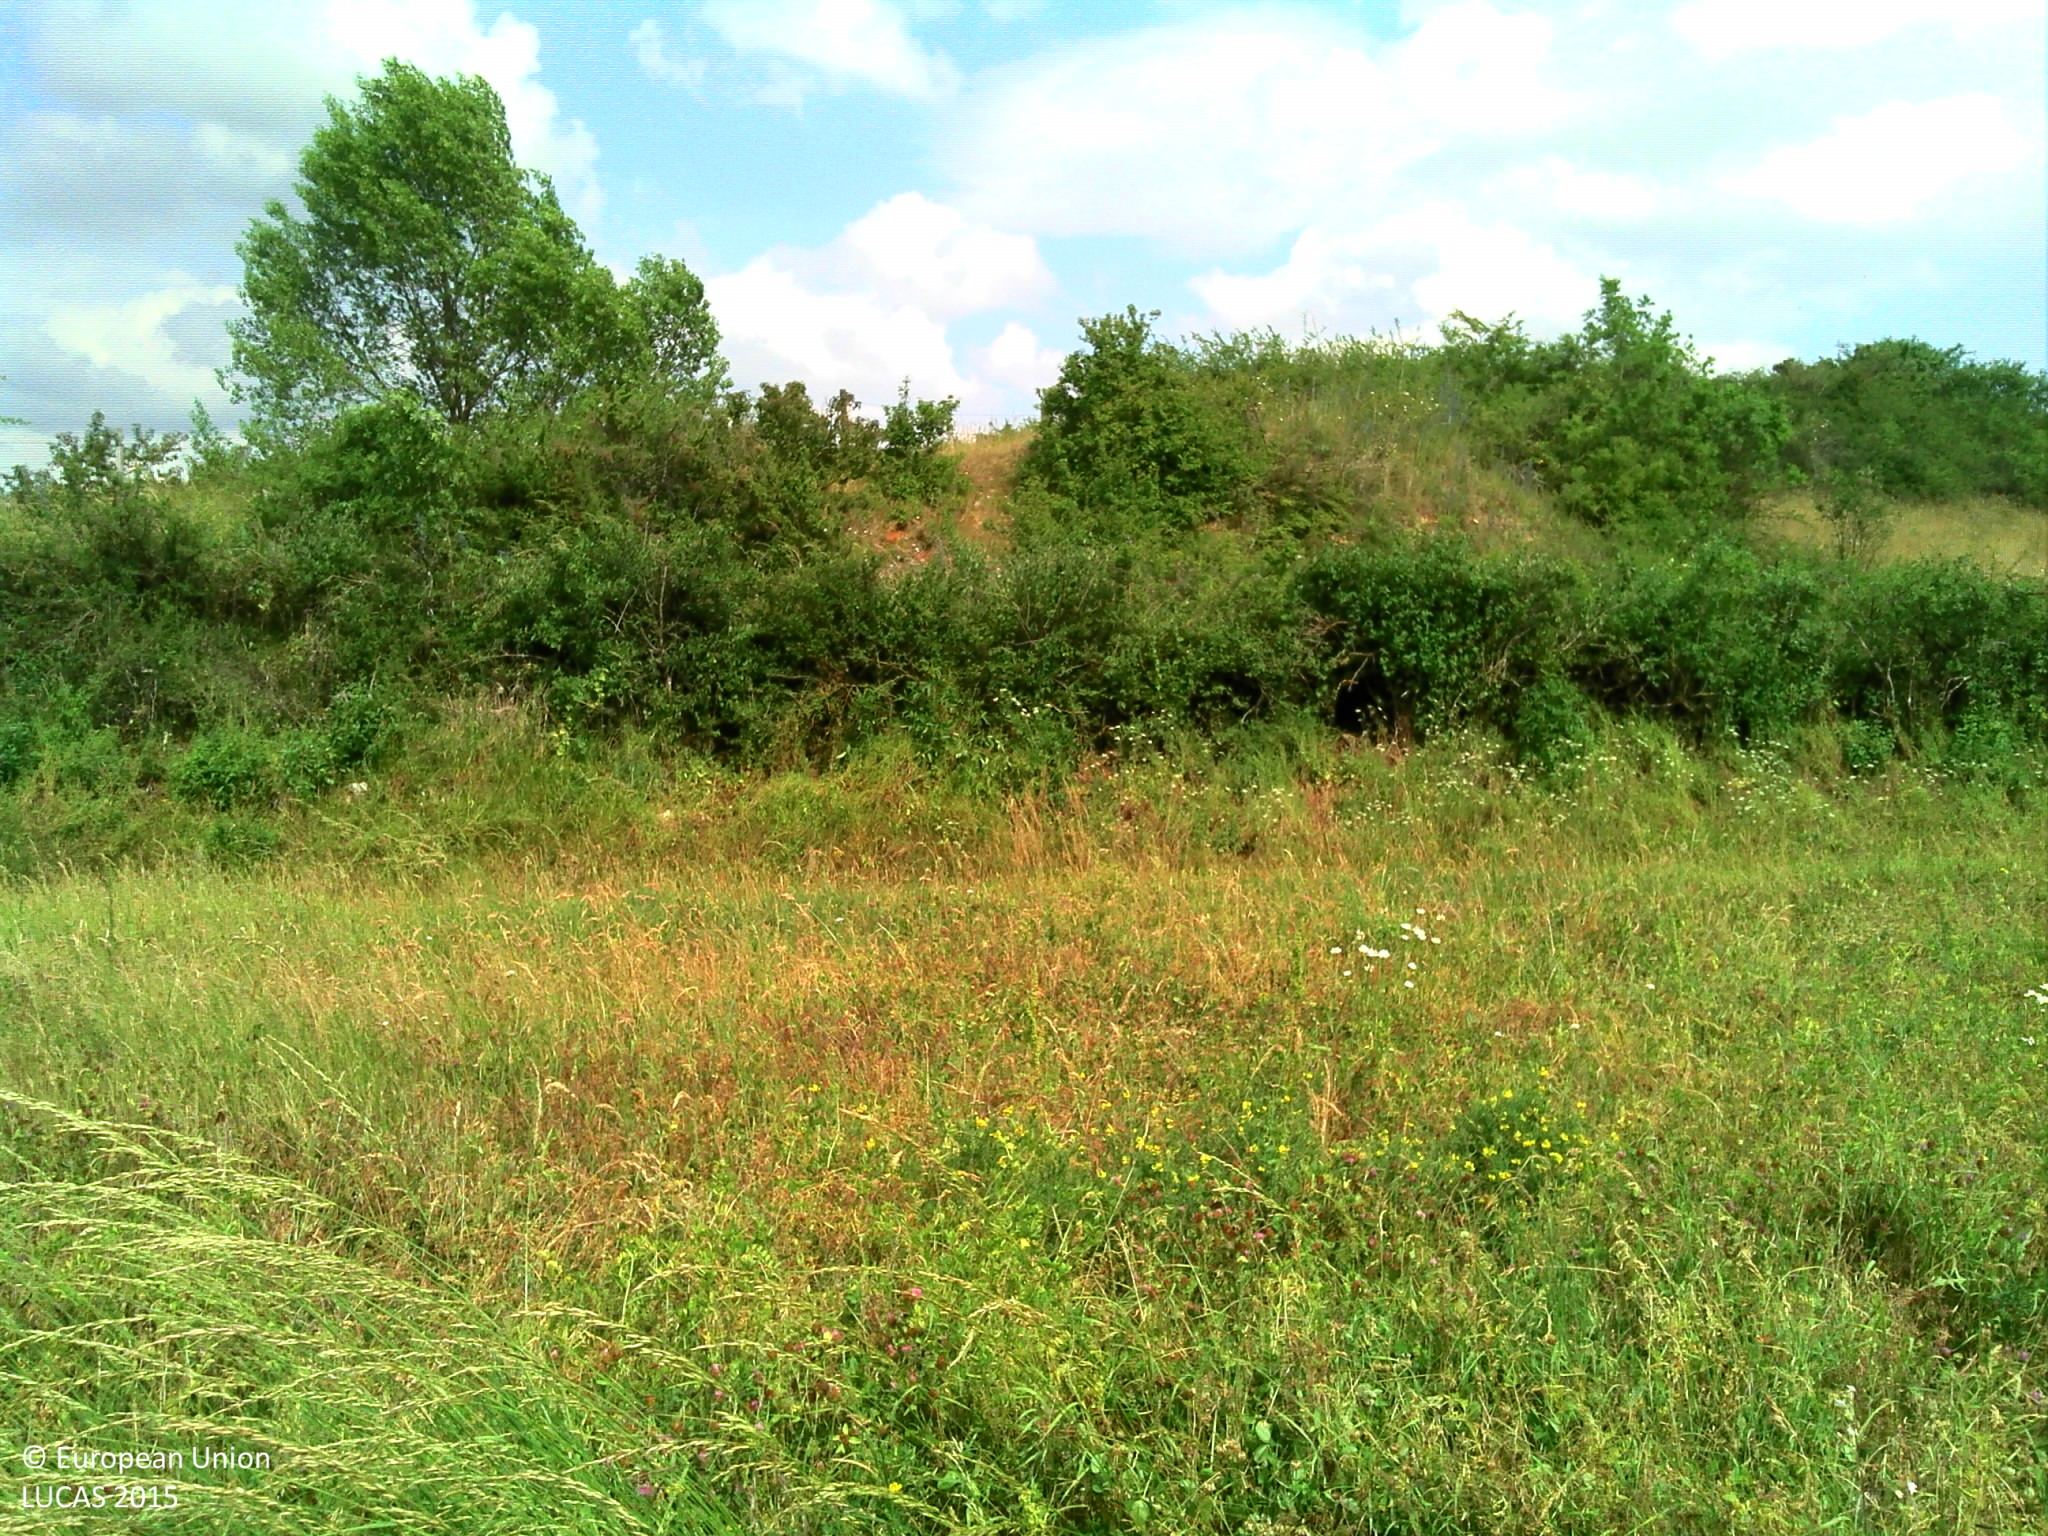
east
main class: Grassland
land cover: Spontaneously vegetated surfaces
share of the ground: > 75 %
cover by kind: herbaceous plants 95 %, shrubs 5 %
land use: Fallow land
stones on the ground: > 50 %
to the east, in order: Spontaneously vegetated surfaces; Managed hedges; Artificial constructions in urban areas; Grassland without tree/shrub cover; Tracks; Grassland with sparse tree/shrub cover; Rocks and stones; Grassland with sparse tree/shrub cover; Shrubland with sparse tree cover
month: June
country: FR
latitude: 44.4824
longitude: 2.5721
